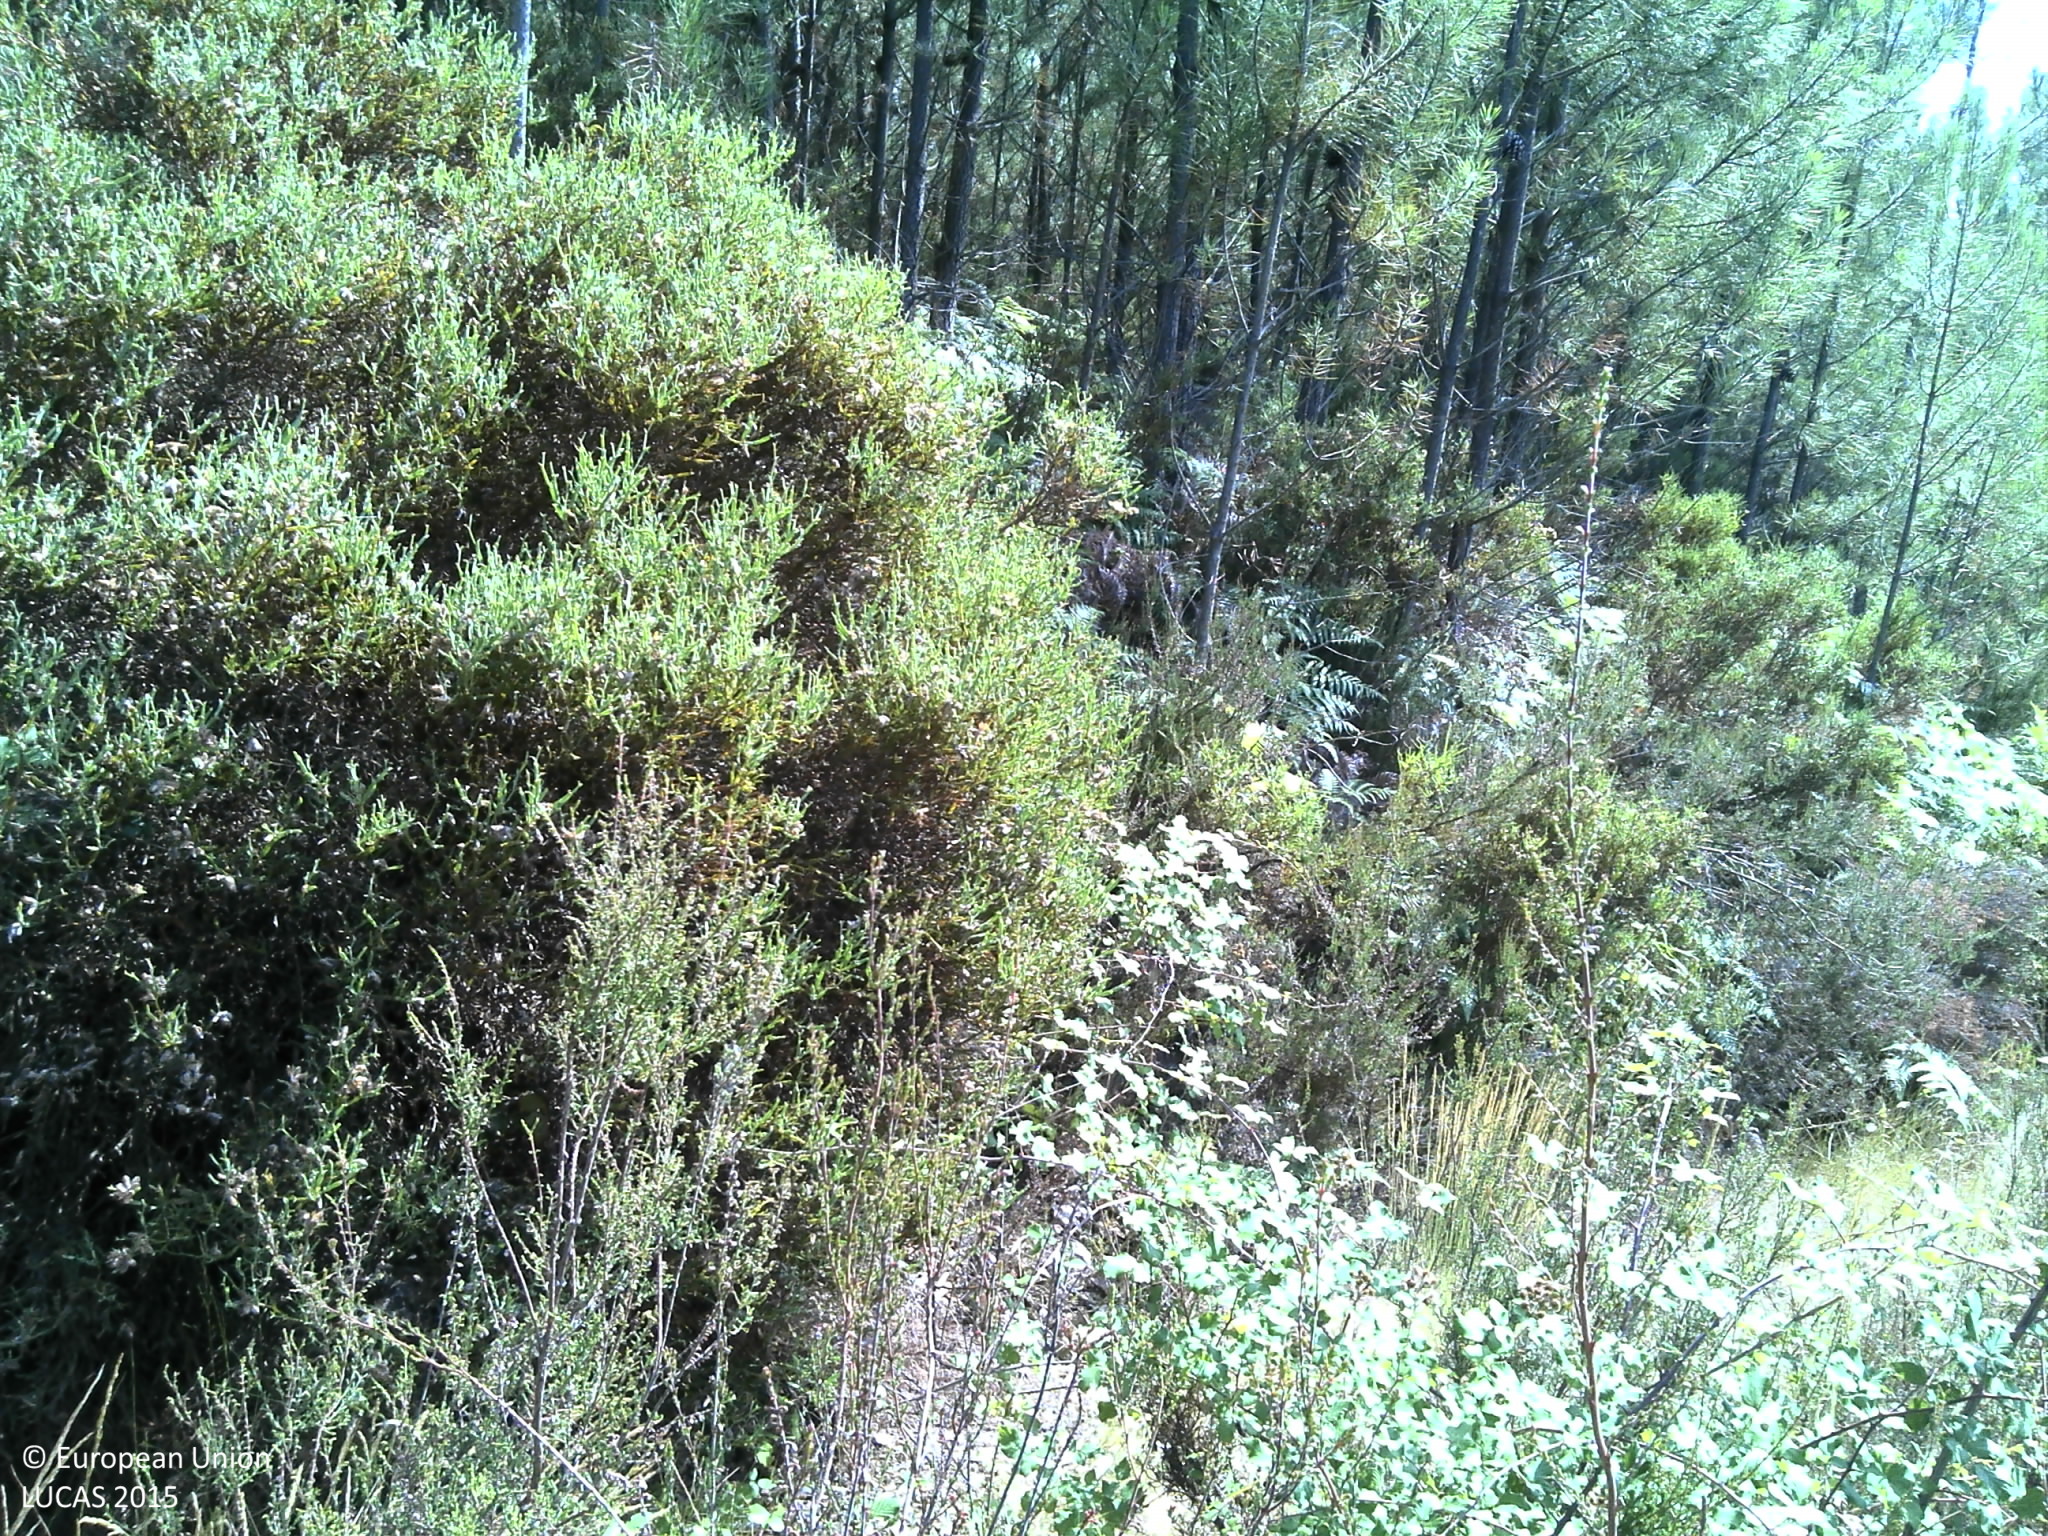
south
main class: Woodland
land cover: Pine dominated coniferous woodland
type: coniferous forest of the mediterranean region
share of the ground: 25 - 50 %
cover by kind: shrubs 65 %, coniferous forest trees 30 %, herbaceous plants 5 %
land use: Forestry
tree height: > 5 m
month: July
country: PT
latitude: 39.9130
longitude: -8.0244
